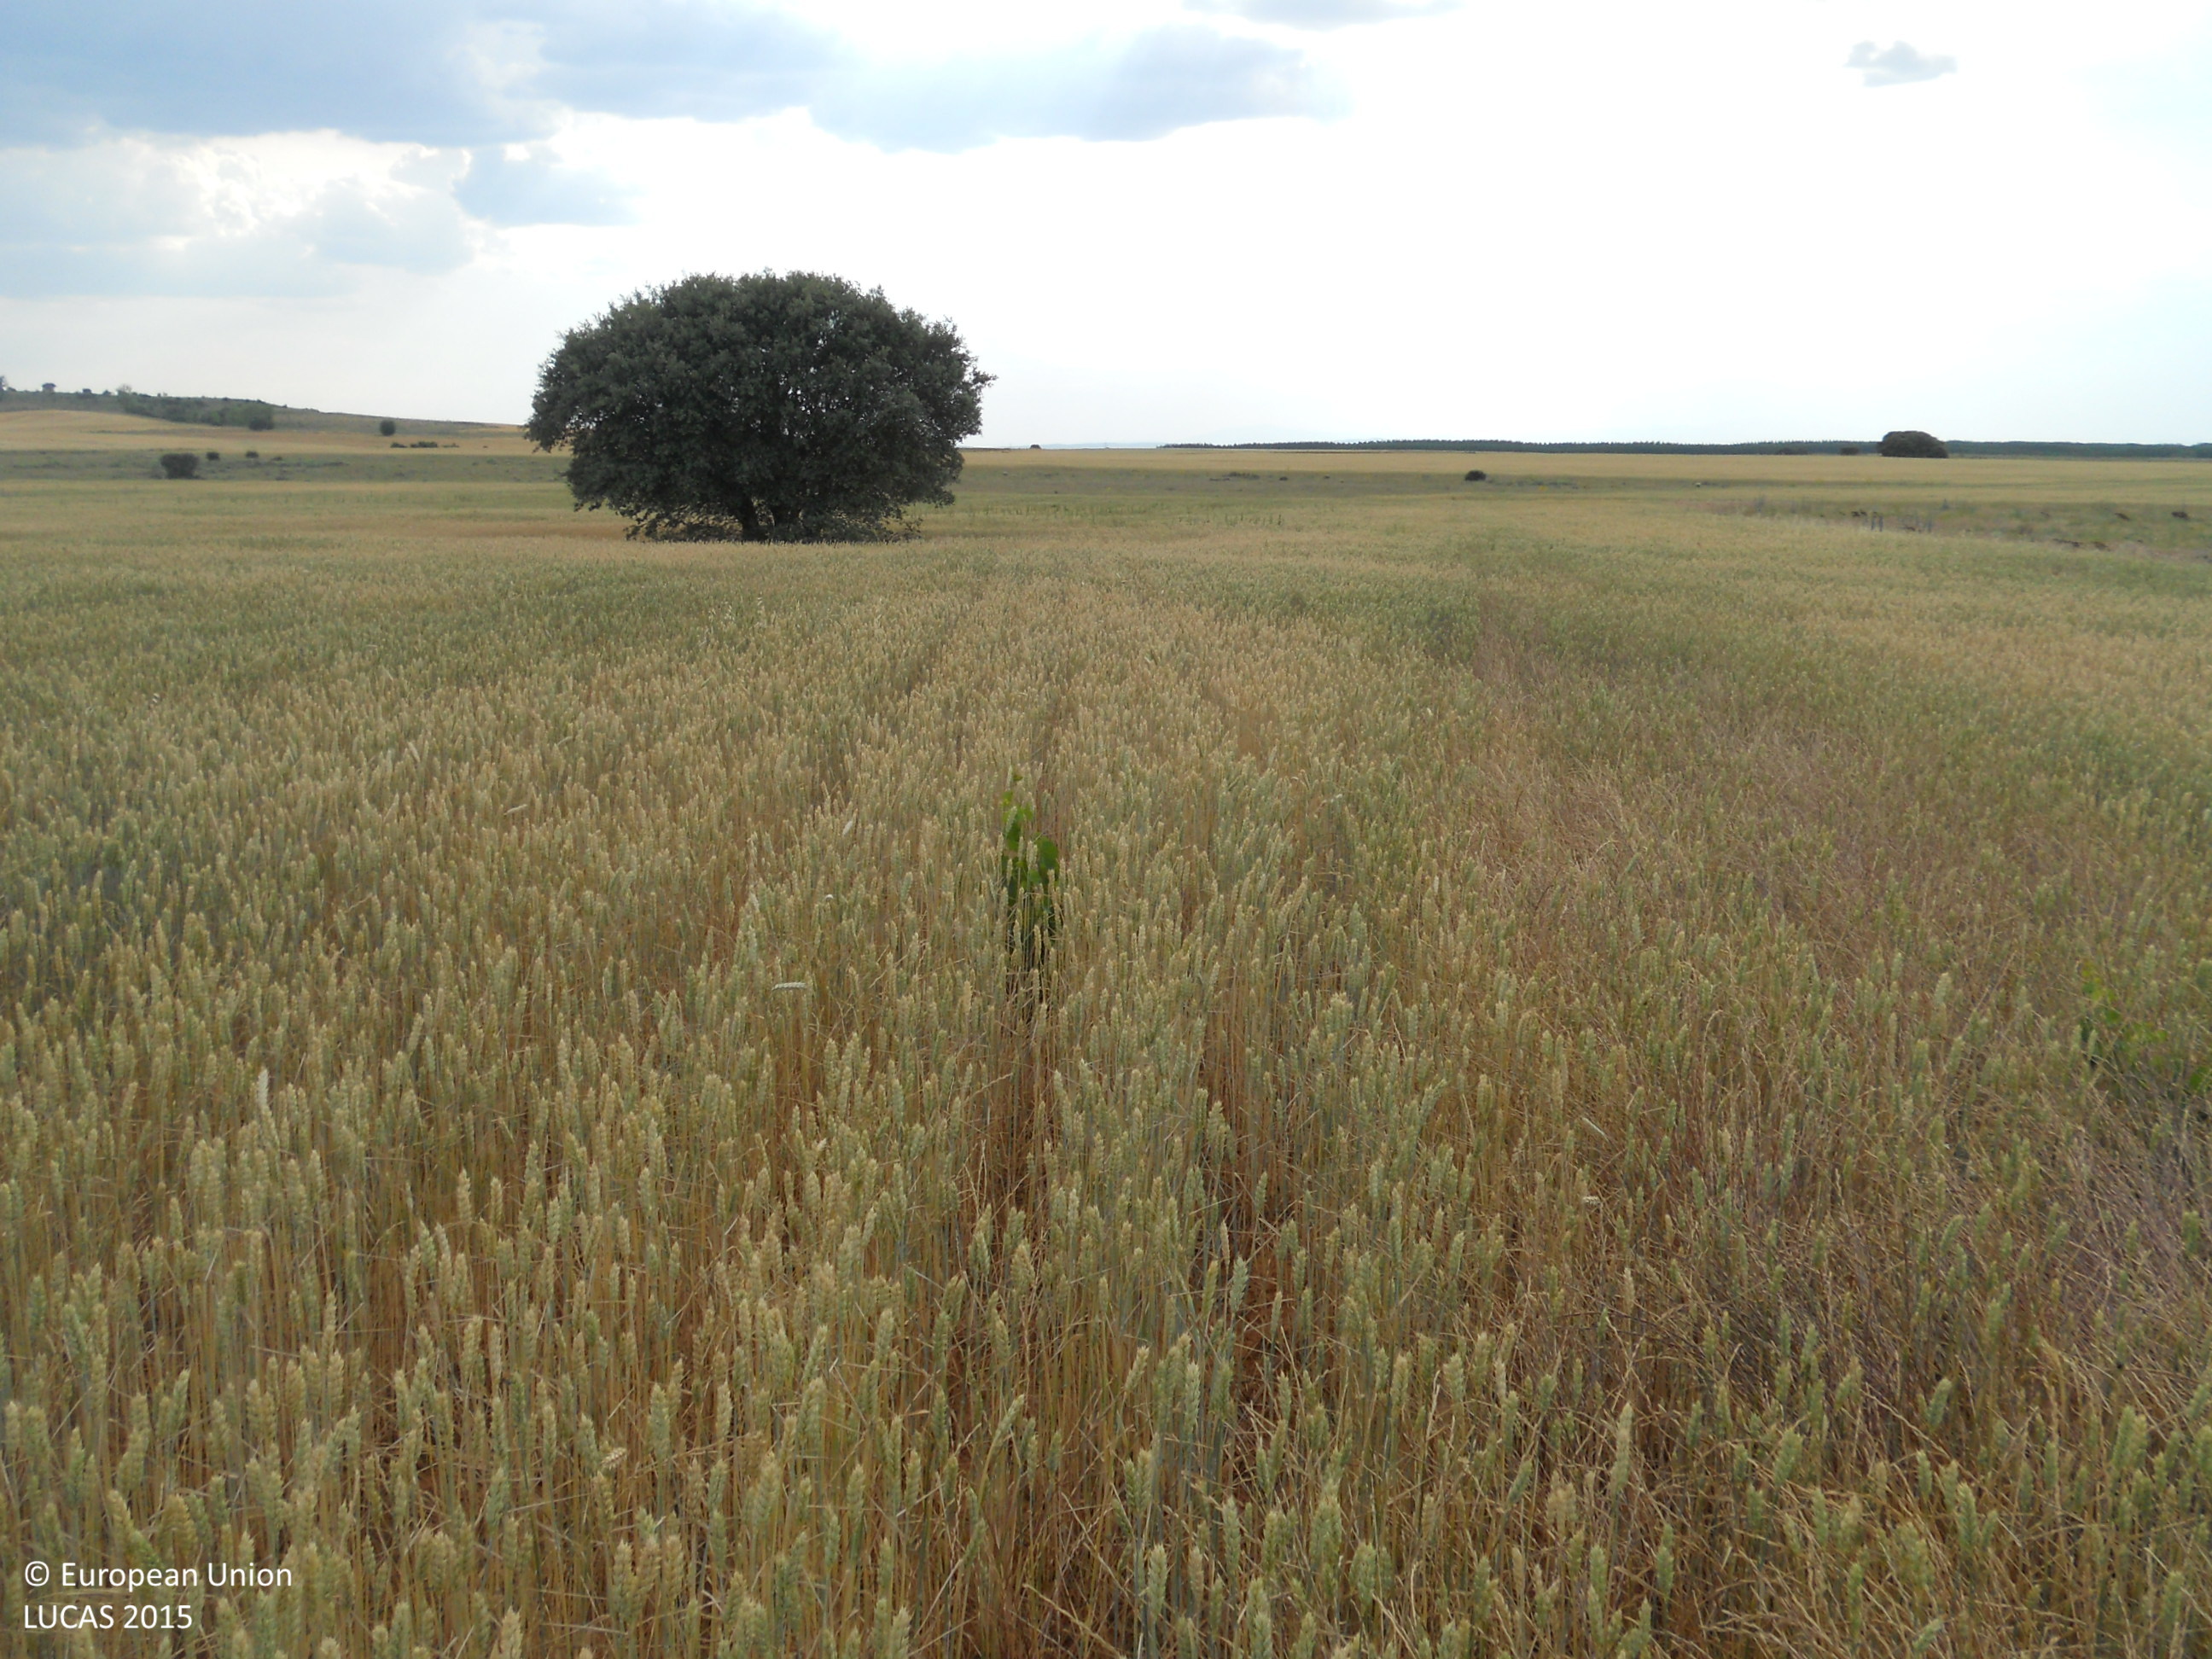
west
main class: Cropland
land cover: Common wheat
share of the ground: > 75 %
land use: Agriculture (excluding fallow land and kitchen gardens)
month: June
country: ES
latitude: 42.2064
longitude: -5.6085
